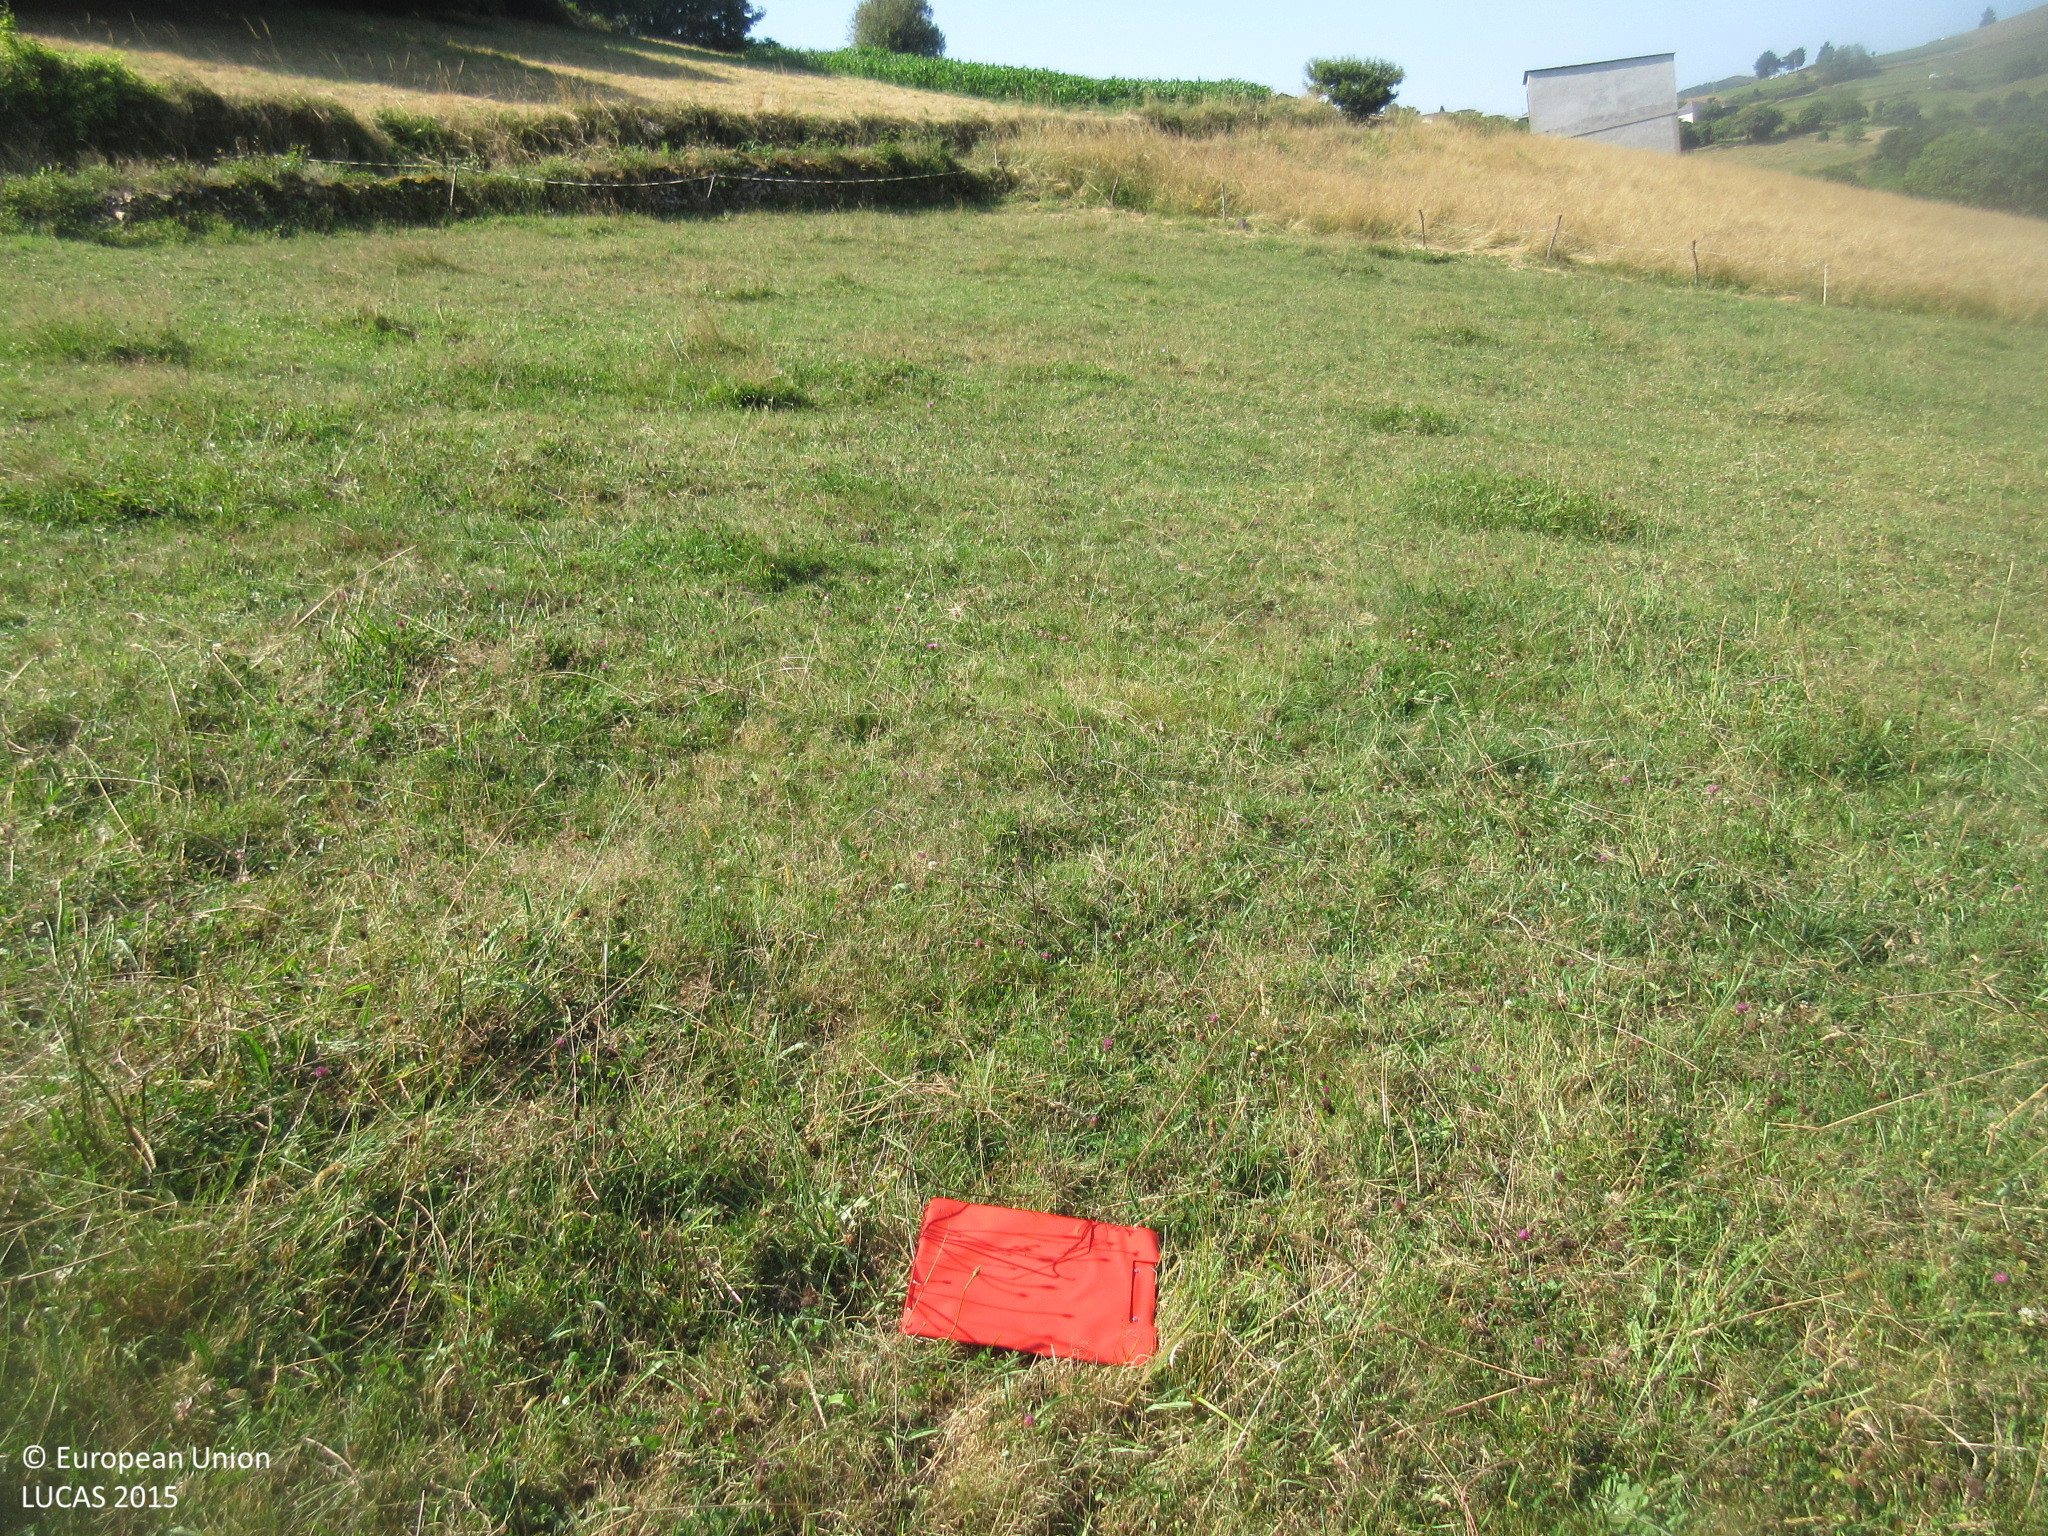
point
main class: Grassland
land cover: Grassland without tree/shrub cover
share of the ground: > 75 %
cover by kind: herbaceous plants 100 %
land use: Agriculture (excluding fallow land and kitchen gardens)
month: July
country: ES
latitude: 43.3841
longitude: -6.7364
